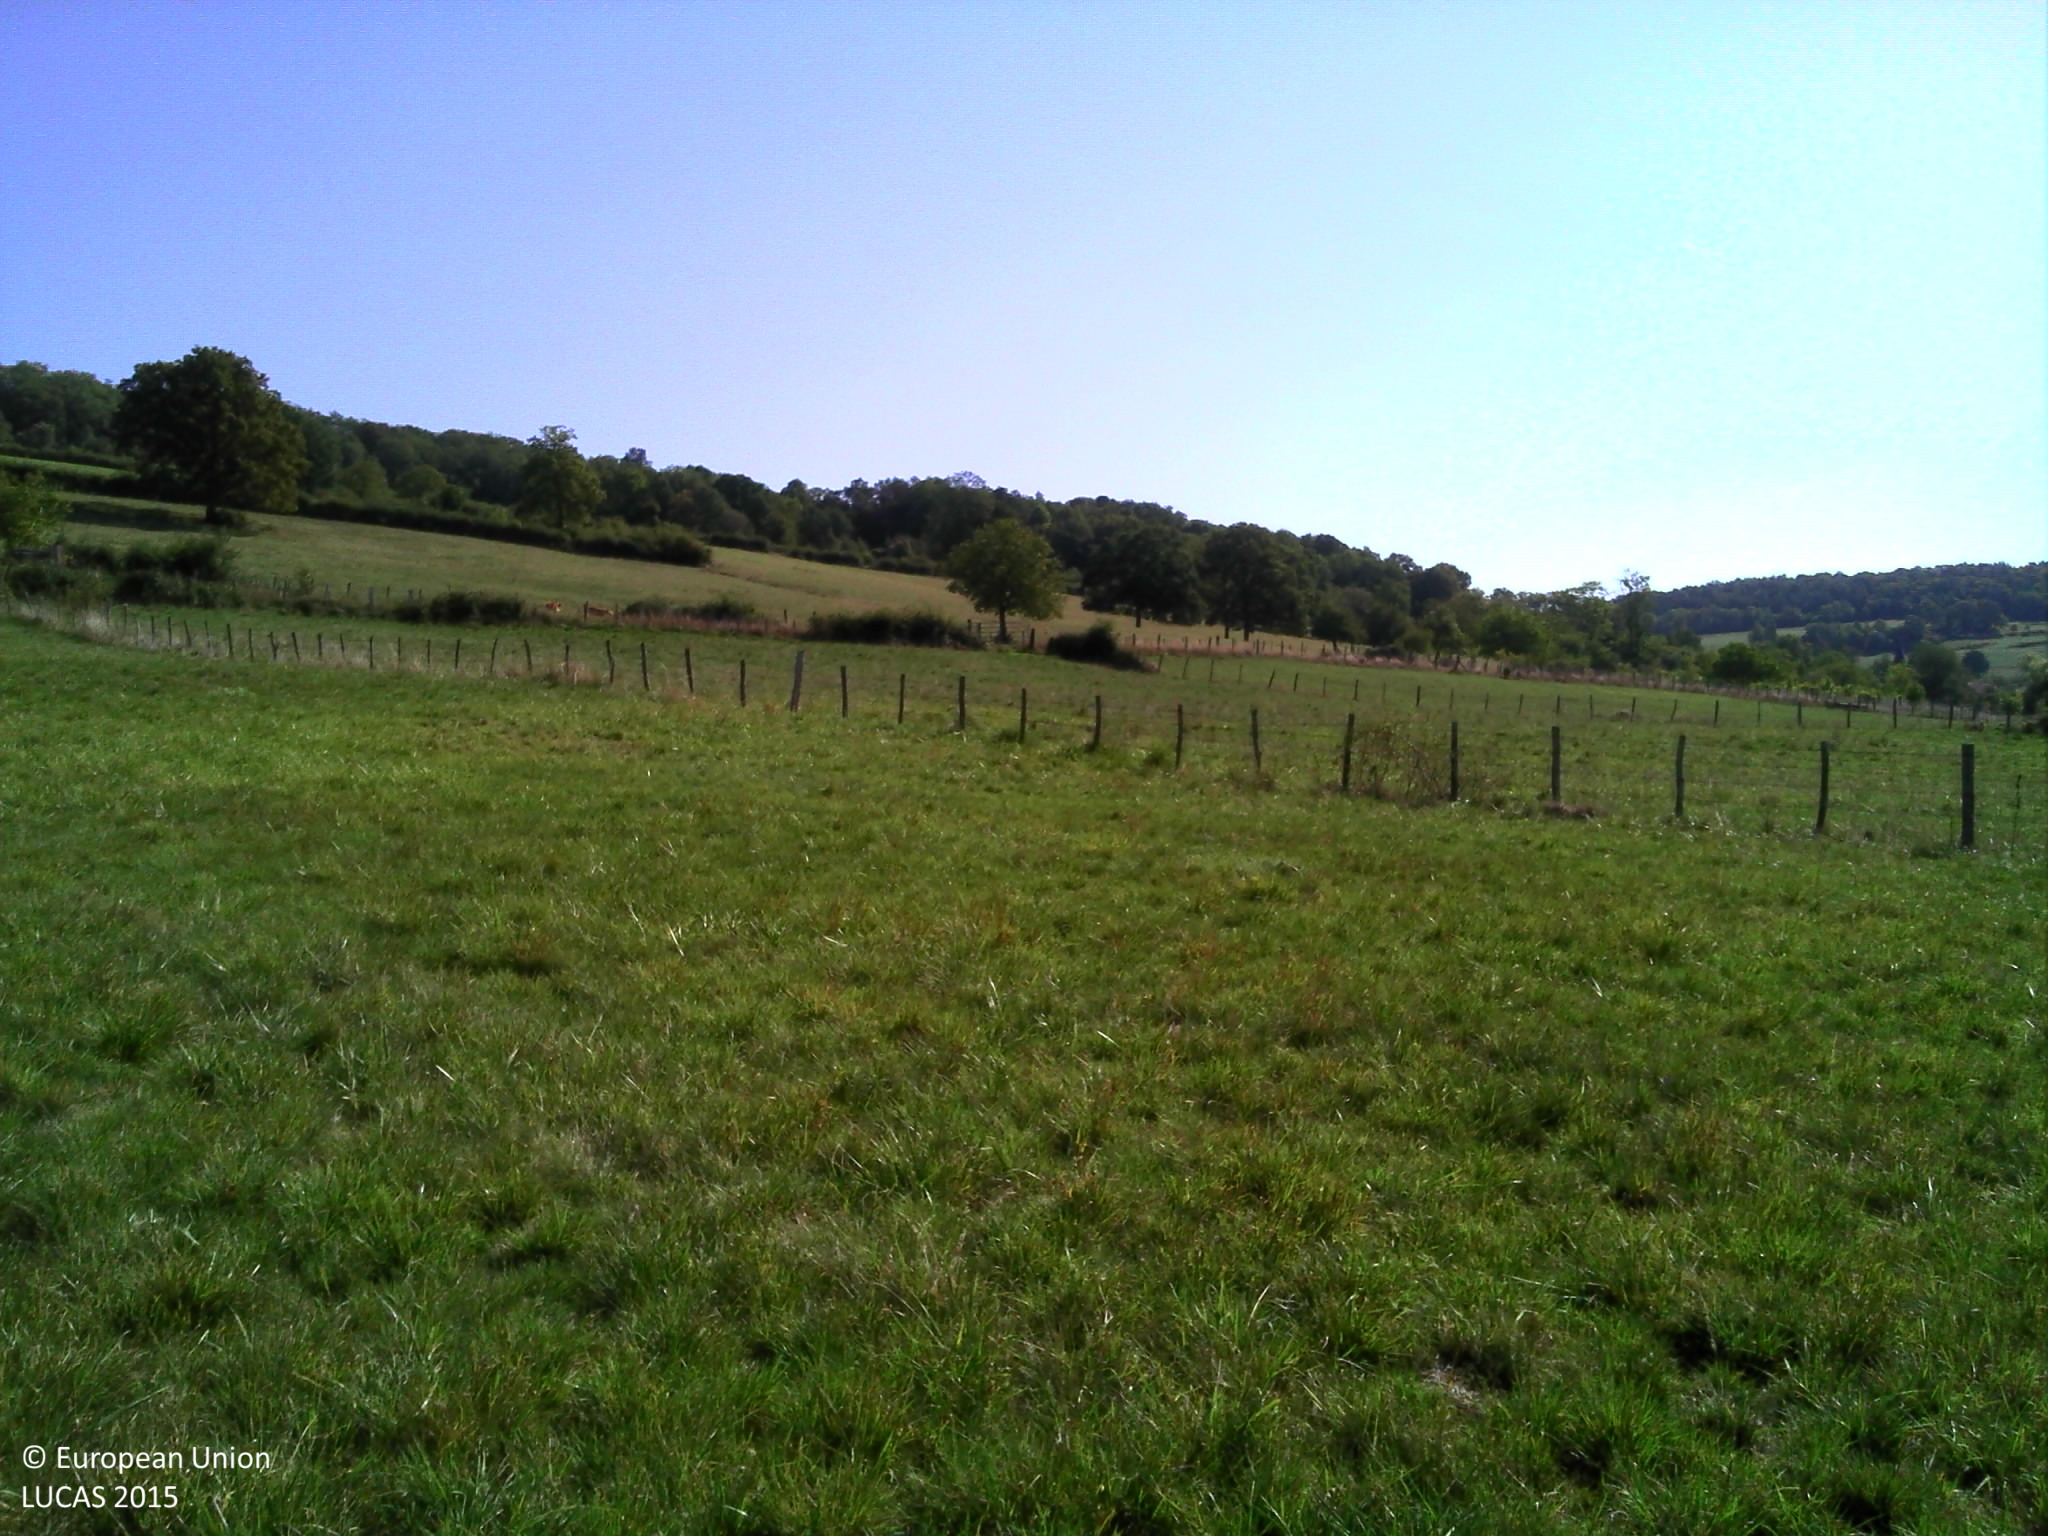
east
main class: Grassland
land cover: Grassland without tree/shrub cover
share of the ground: > 75 %
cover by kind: herbaceous plants 100 %
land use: Agriculture (excluding fallow land and kitchen gardens)
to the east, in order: Grassland without tree/shrub cover; Fences; Grassland without tree/shrub cover; Fences; Grass margins; Tracks; Grass margins; Fences; Grassland without tree/shrub cover; Ditches and canals; Grassland without tree/shrub cover
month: September
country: FR
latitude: 47.5776
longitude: 4.4283
